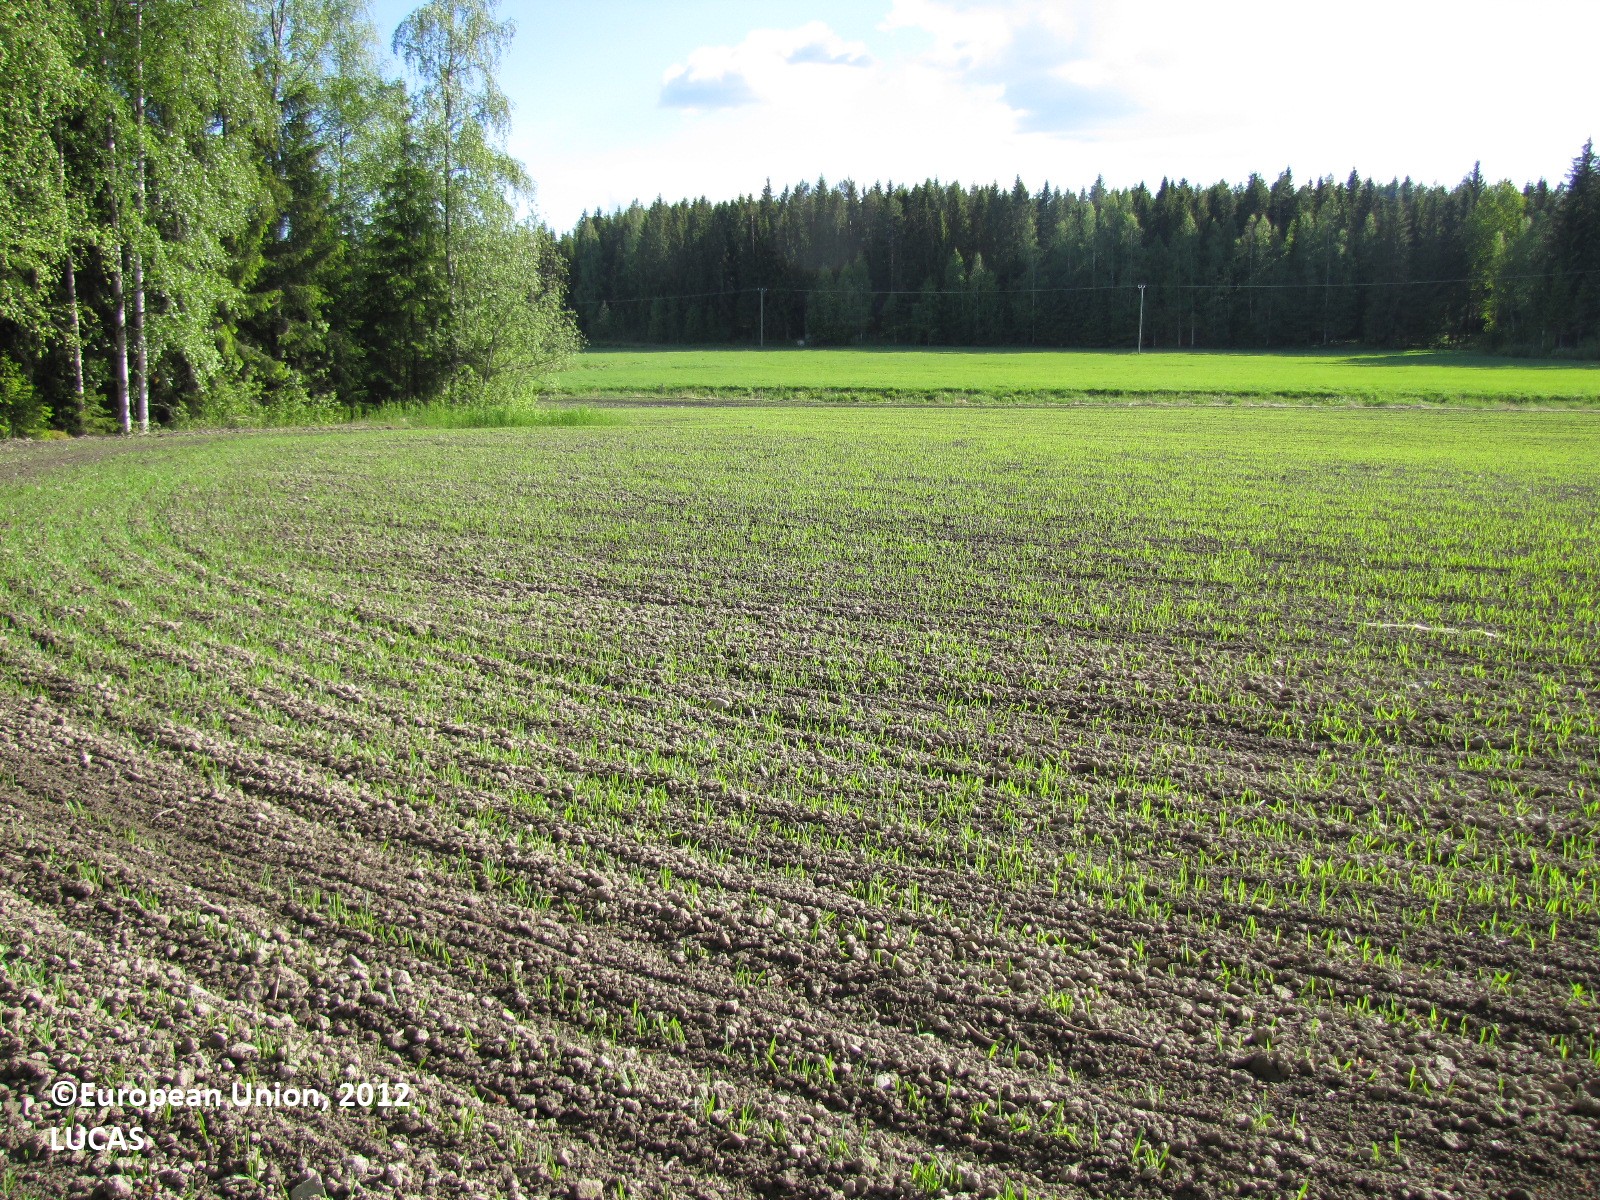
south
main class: Cropland
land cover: Barley
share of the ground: 25 - 50 %
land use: Agriculture (excluding fallow land and kitchen gardens)
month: June
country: FI
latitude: 61.2415
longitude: 22.9850
